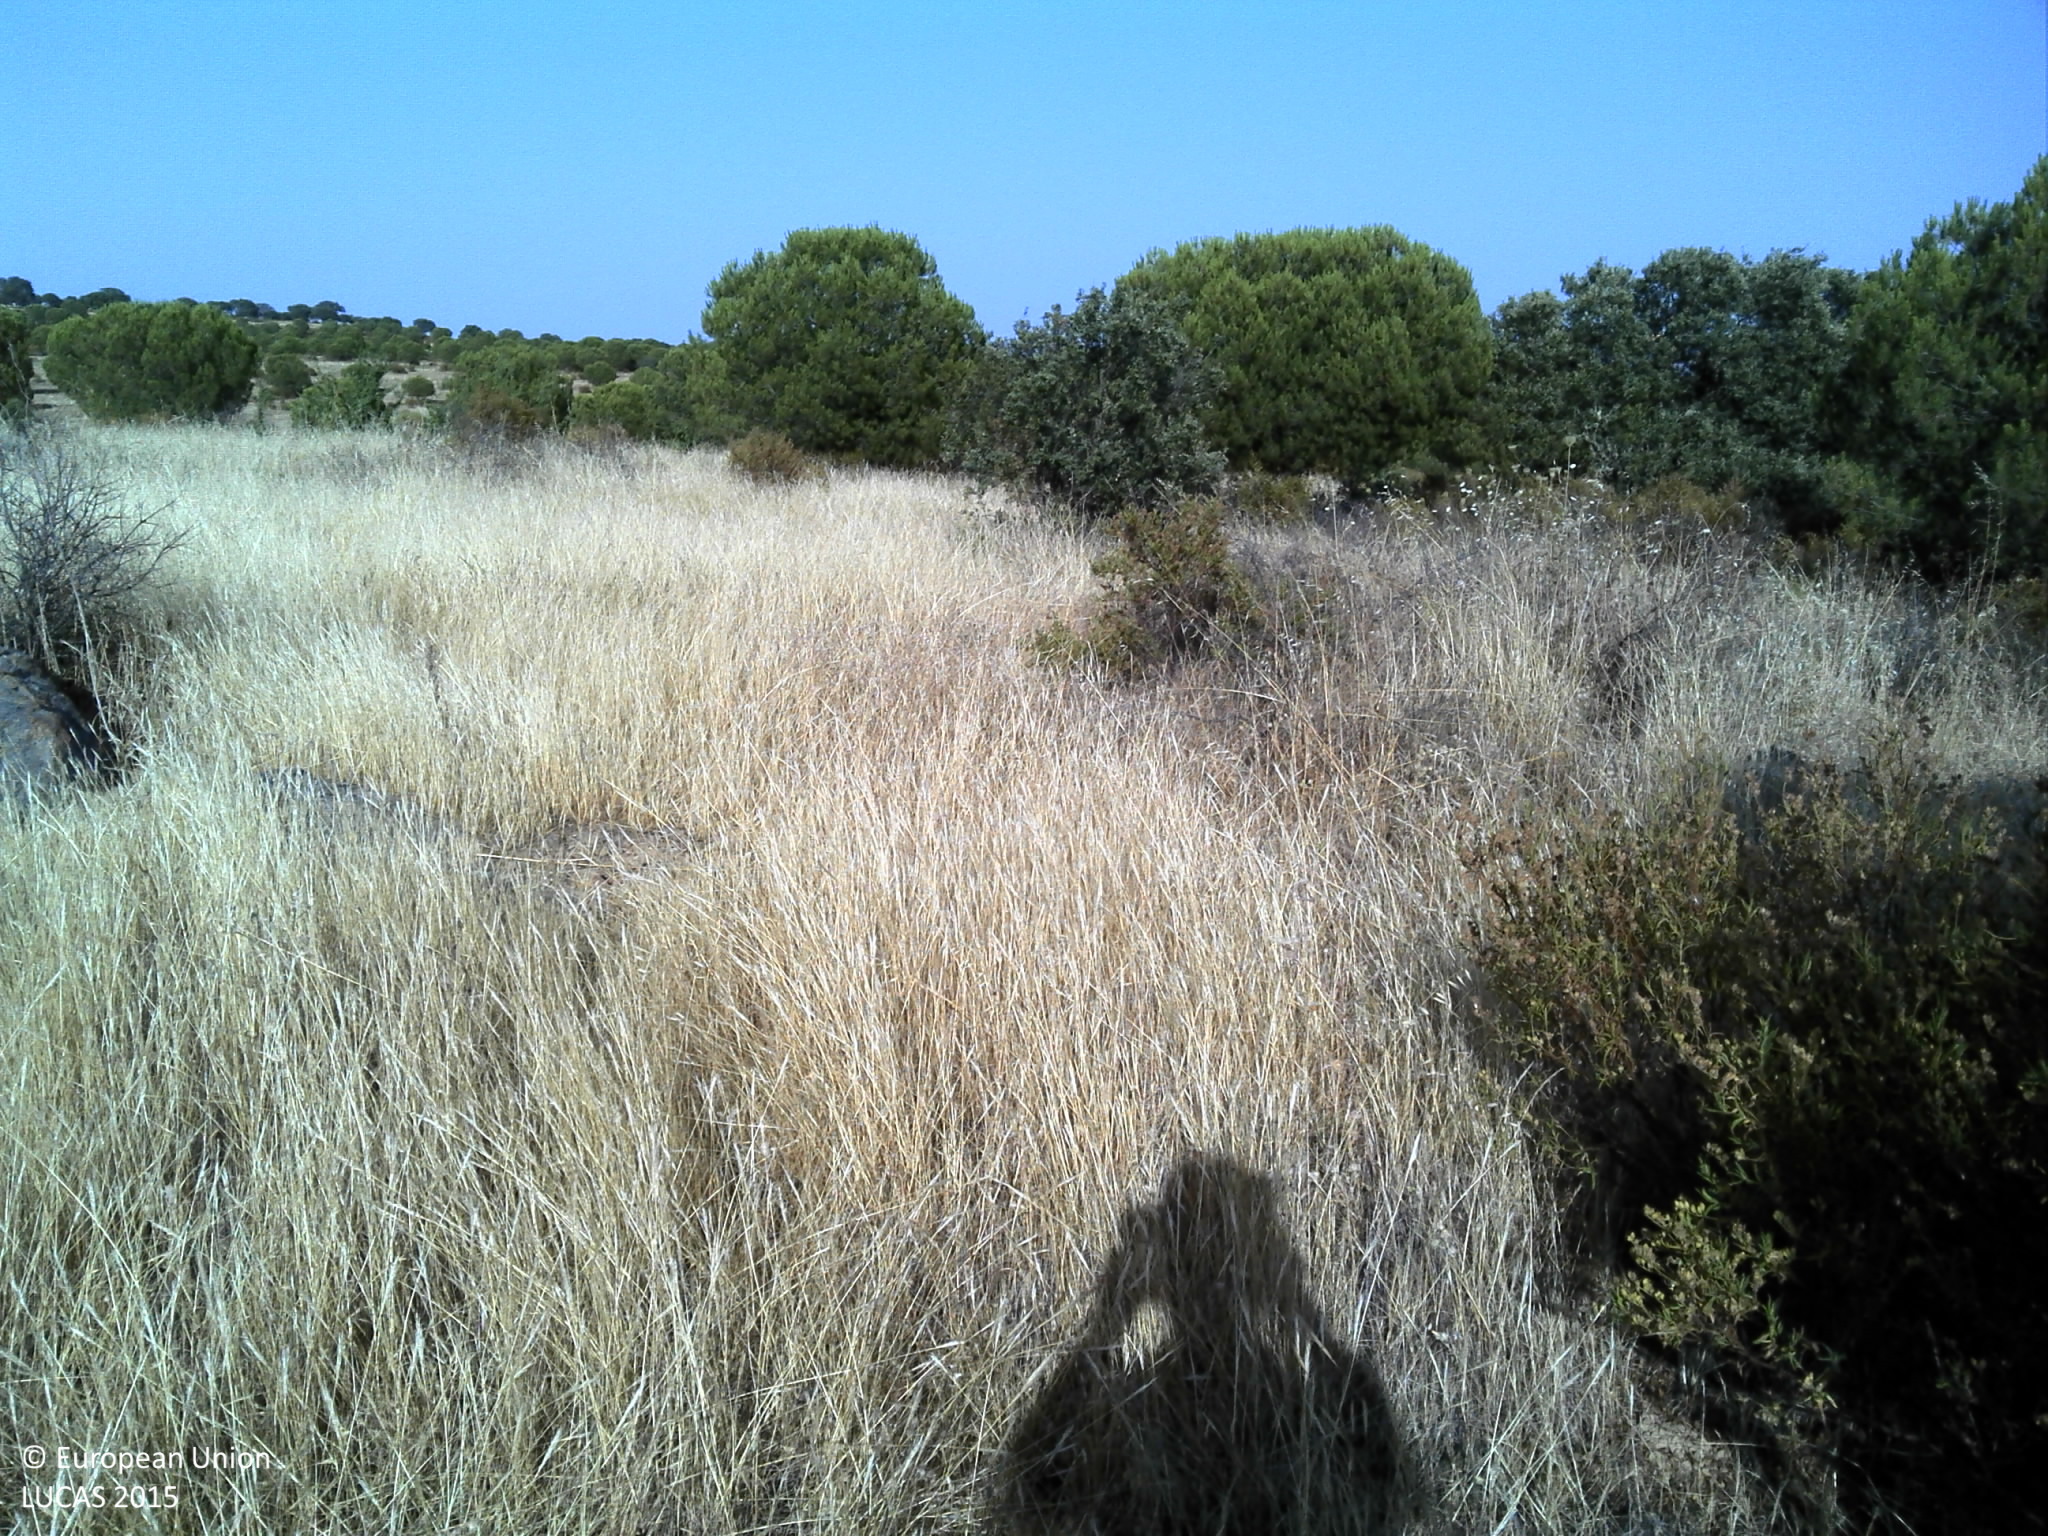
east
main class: Woodland
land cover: Pine dominated coniferous woodland
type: coniferous forest of the mediterranean region
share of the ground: 10 - 25 %
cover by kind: herbaceous plants 65 %, coniferous forest trees 25 %, broadleaved forest trees 5 %, shrubs 5 %
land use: Forestry
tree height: < 5 m
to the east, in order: Pine dominated coniferous woodland; Ditches and canals; Pine dominated mixed woodland; Pine dominated coniferous woodland; Rivers and streams; Shrubland without tree cover; Pine dominated coniferous woodland; Grassland without tree/shrub cover; Broadleaved woodland
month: June
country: PT
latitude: 37.6160
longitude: -7.5617
